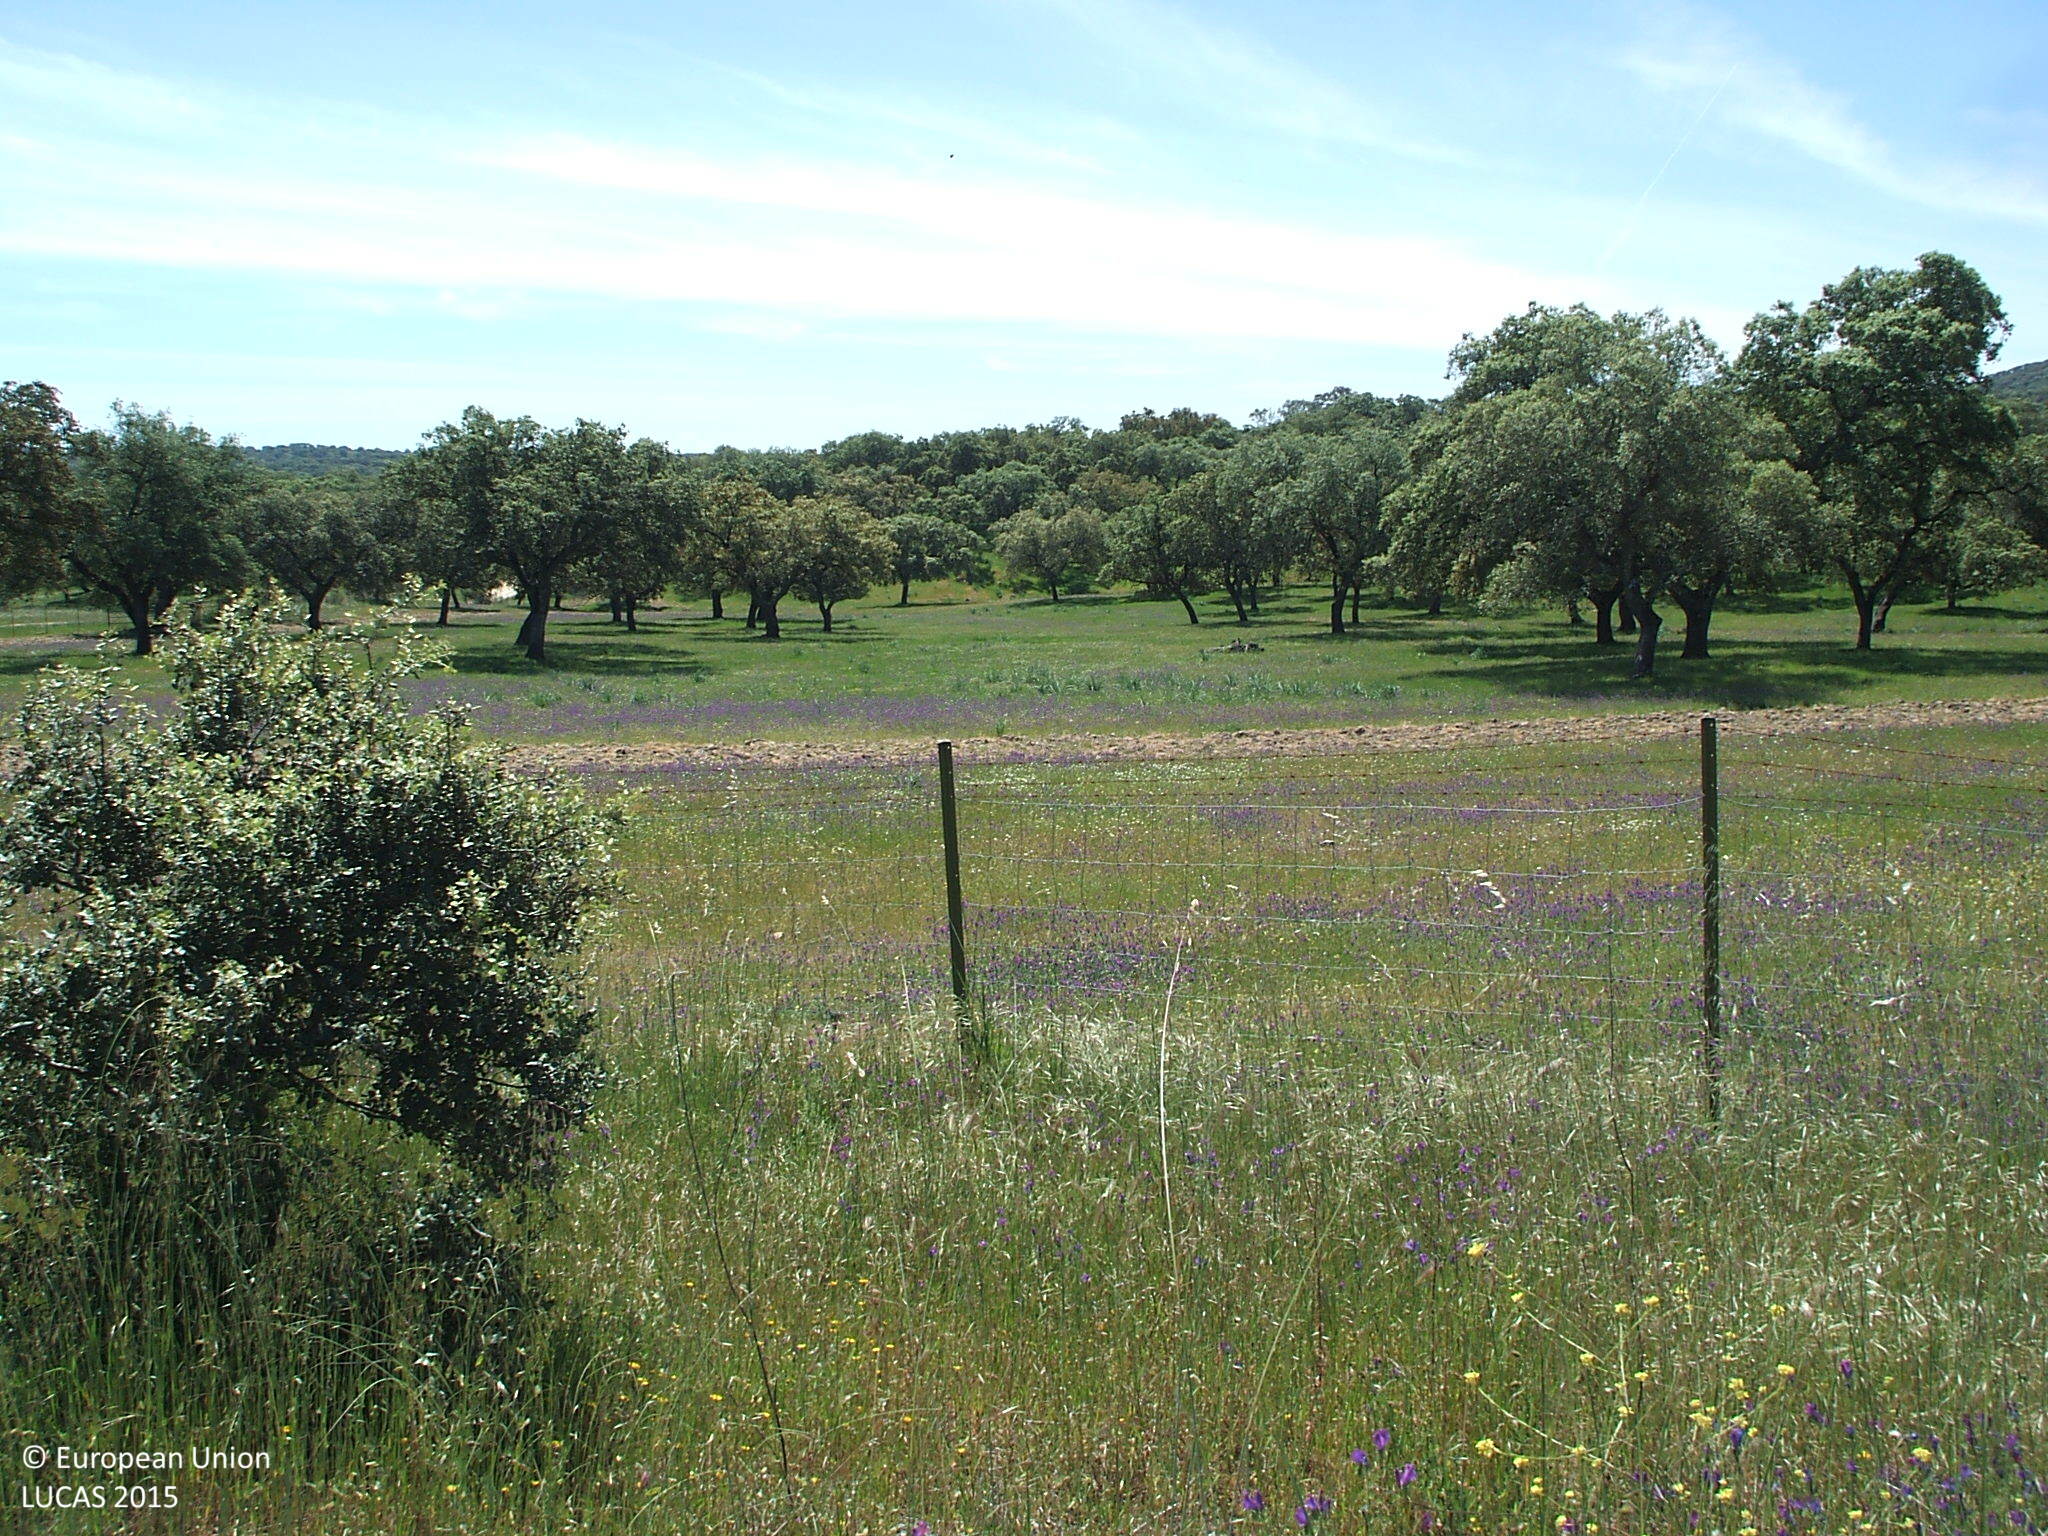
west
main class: Woodland
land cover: Broadleaved woodland
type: broadleaved evergreen forest
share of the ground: 25 - 50 %
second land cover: Grassland without tree/shrub cover
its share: > 75 %
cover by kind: herbaceous plants 60 %, broadleaved forest trees 40 %
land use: Forestry
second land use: Agriculture (excluding fallow land and kitchen gardens)
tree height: > 5 m
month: April
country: ES
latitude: 37.7683
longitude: -5.6574
